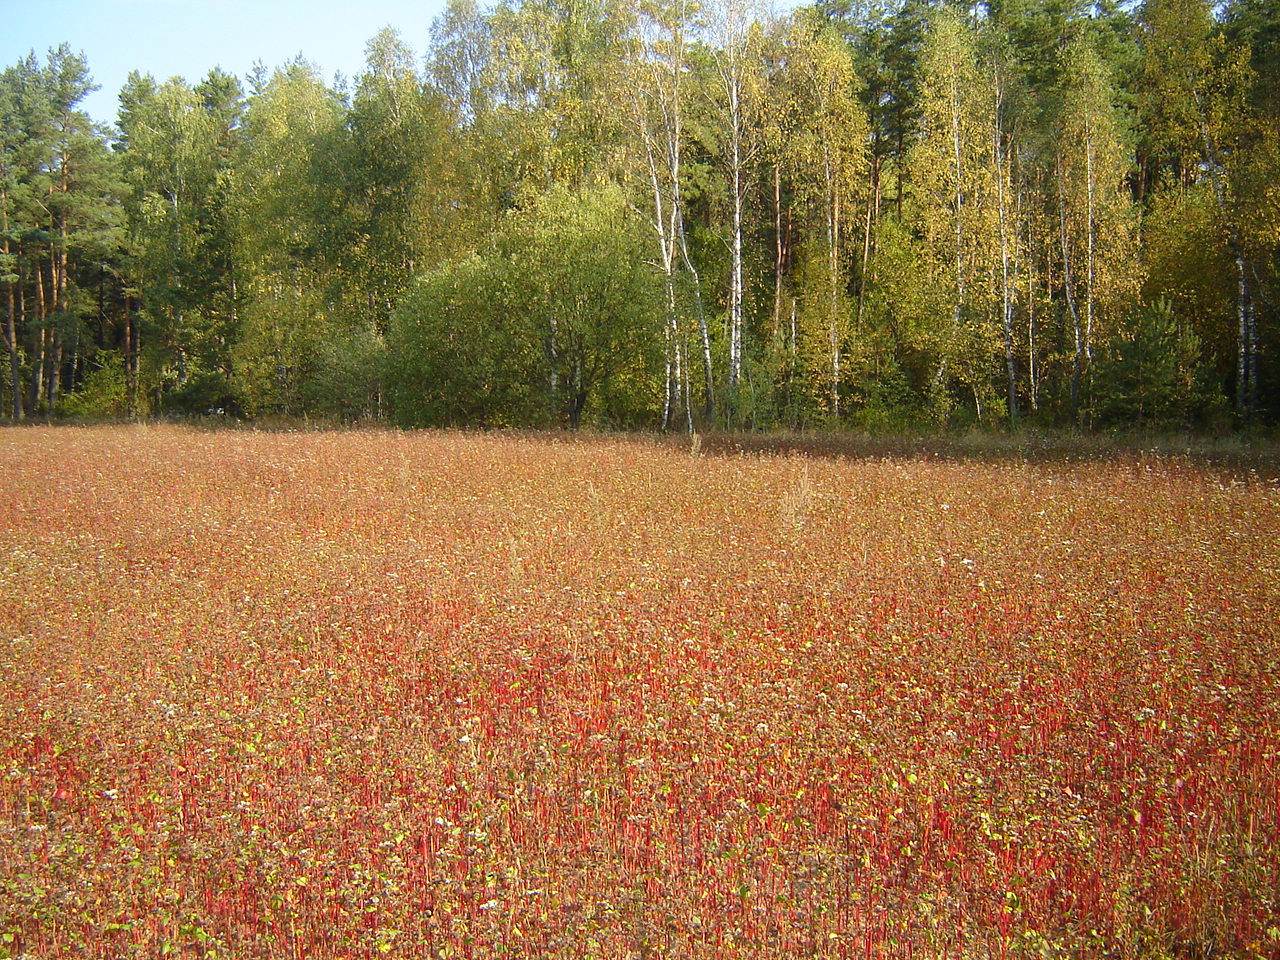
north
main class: Cropland
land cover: Other cereals
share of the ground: > 75 %
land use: Agriculture (excluding fallow land and kitchen gardens)
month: August
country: LT
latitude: 54.5796
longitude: 24.8872
